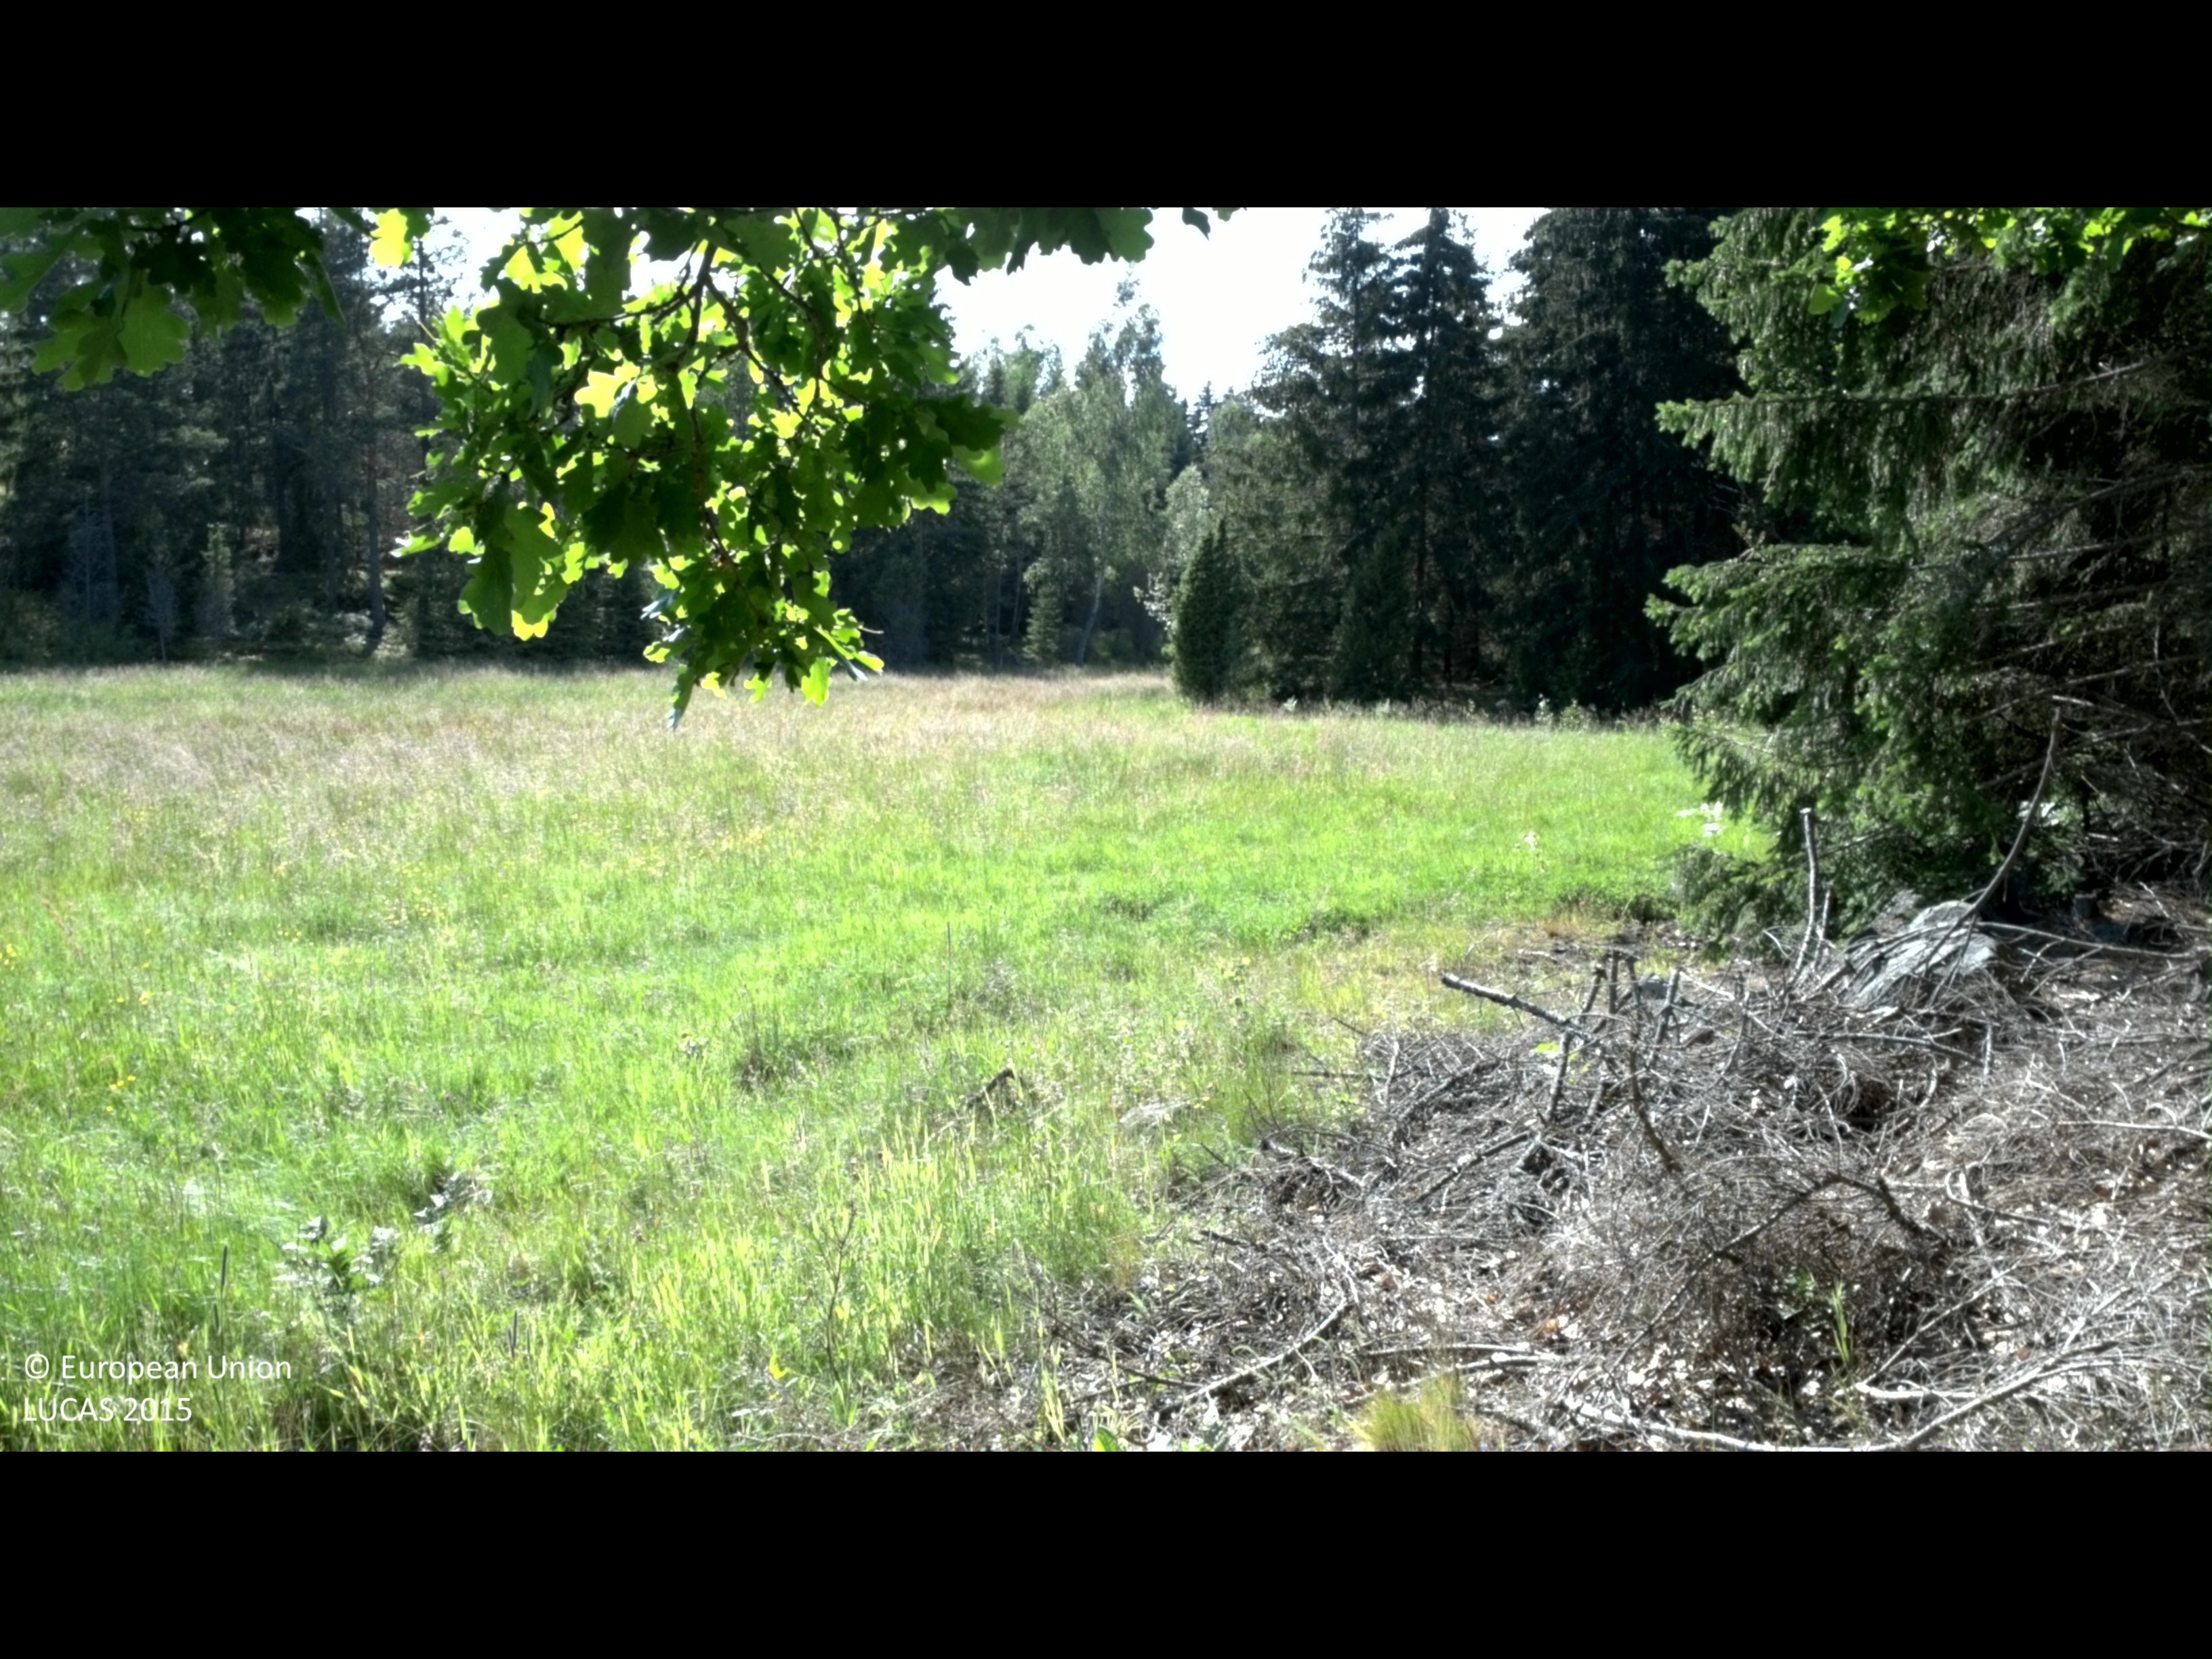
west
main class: Woodland
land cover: Spruce dominated mixed woodland
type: boreal forest
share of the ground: > 75 %
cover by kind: coniferous forest trees 65 %, broadleaved forest trees 25 %, herbaceous plants 5 %, unconsolidated bare surface 5 %
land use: Forestry
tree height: > 5 m
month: June
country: SE
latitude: 58.0366
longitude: 16.6541
